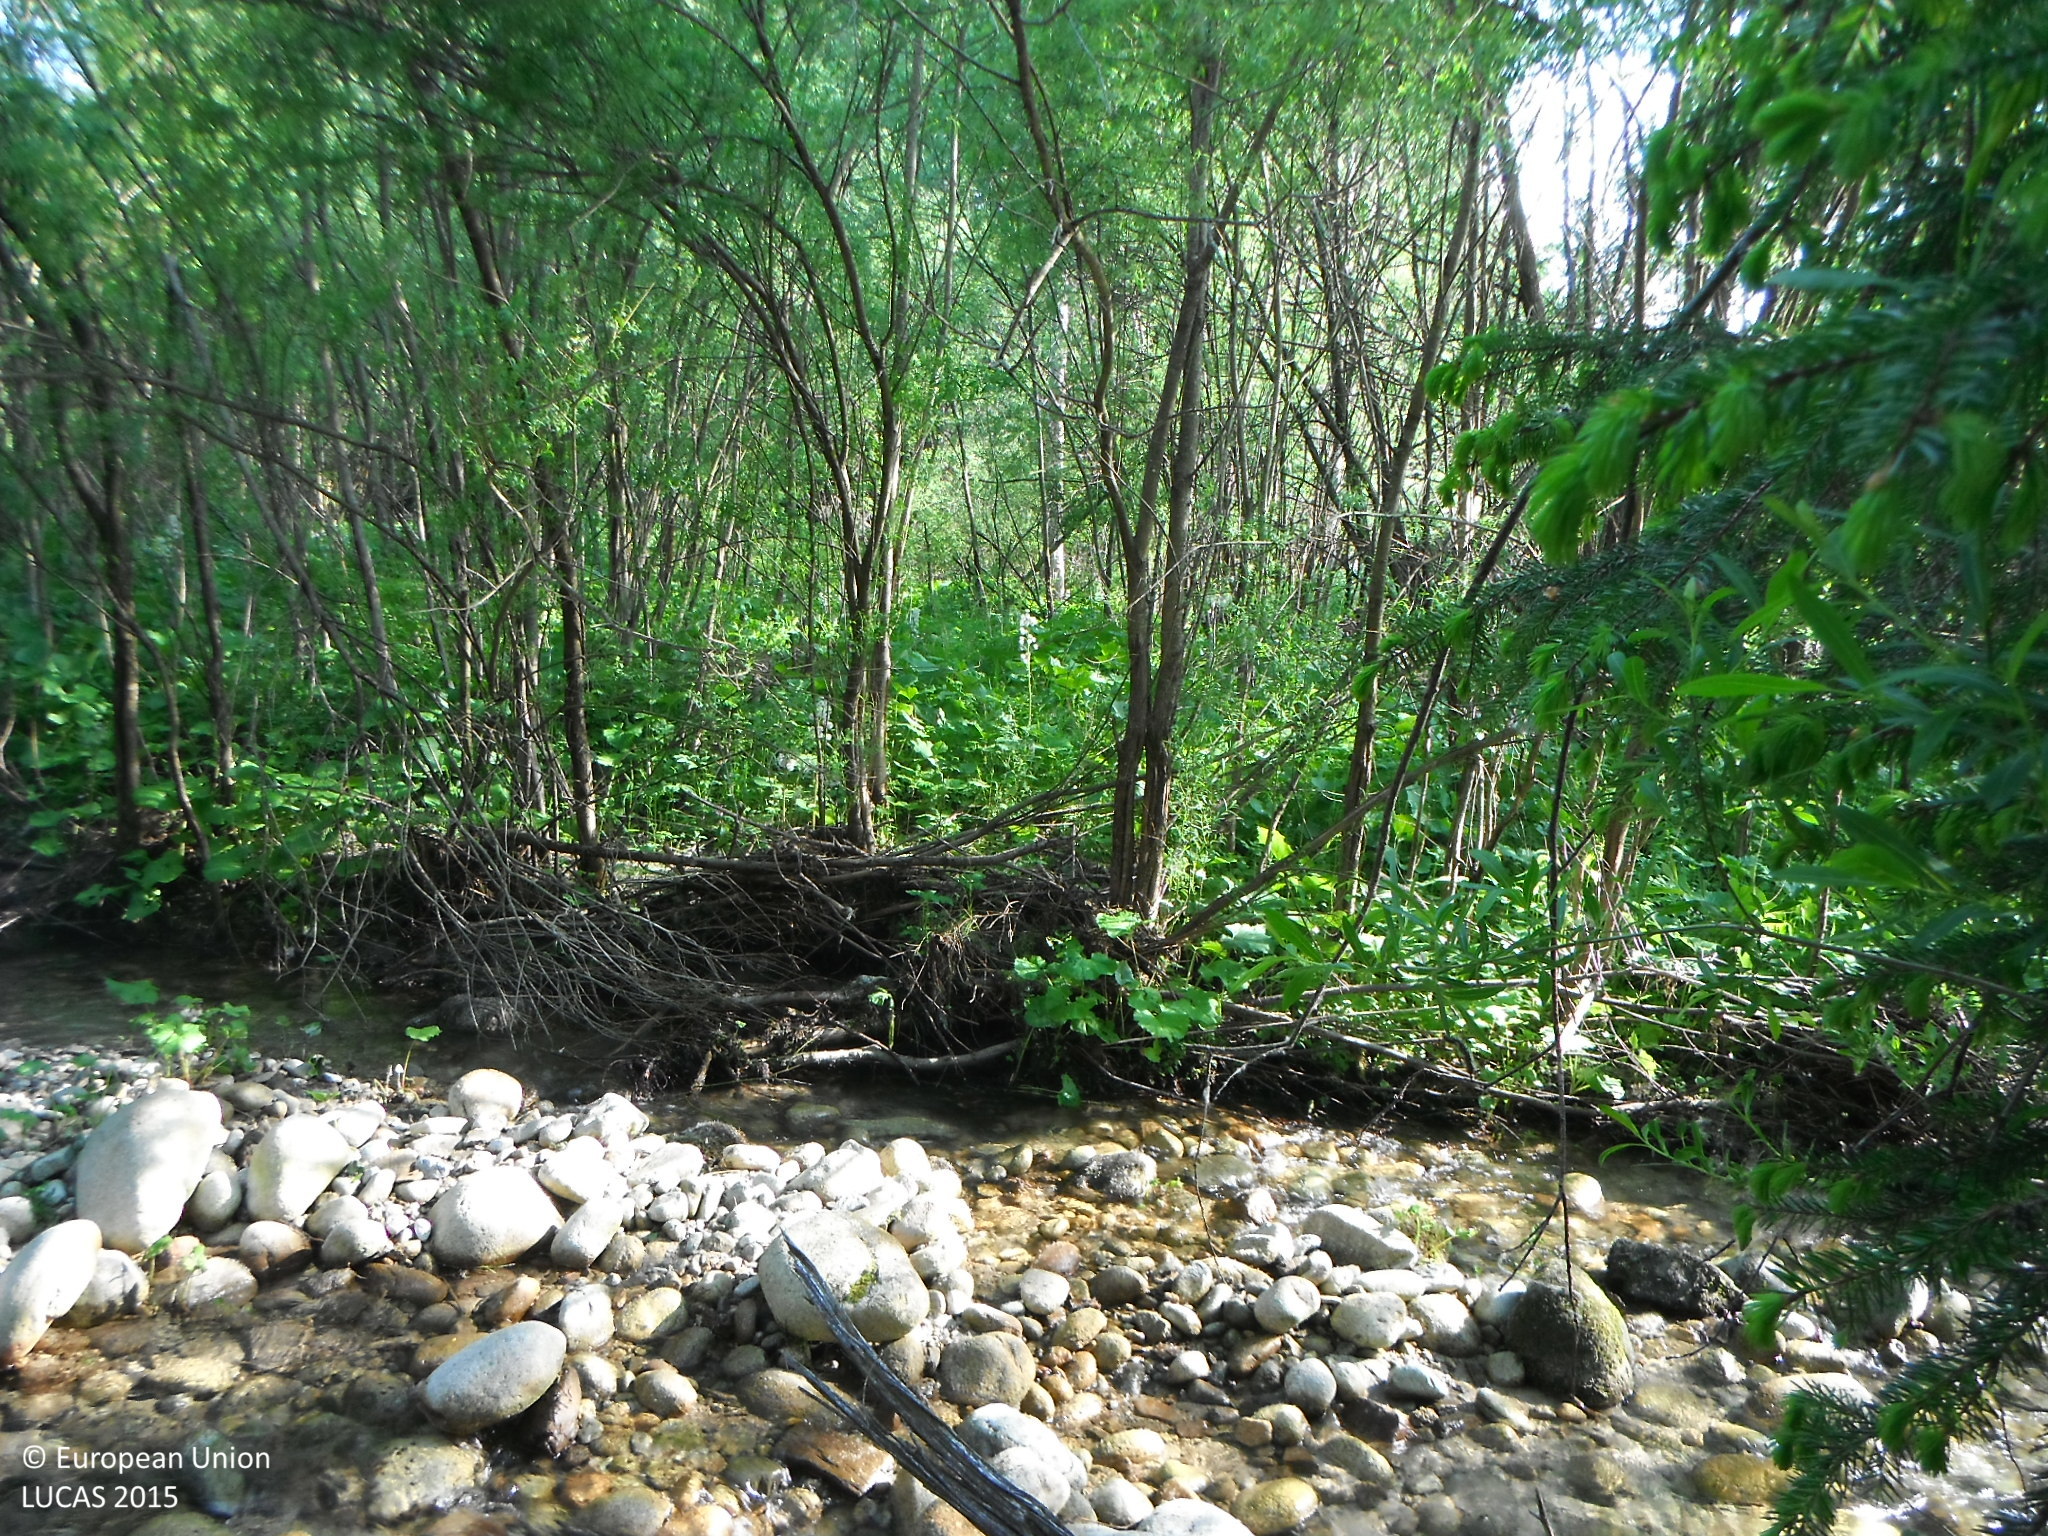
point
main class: Woodland
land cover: Broadleaved woodland
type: mesophytic deciduous forest
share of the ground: > 75 %
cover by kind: broadleaved forest trees 100 %
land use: Forestry
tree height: > 5 m
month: June
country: SK
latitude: 49.1068
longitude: 19.8234
